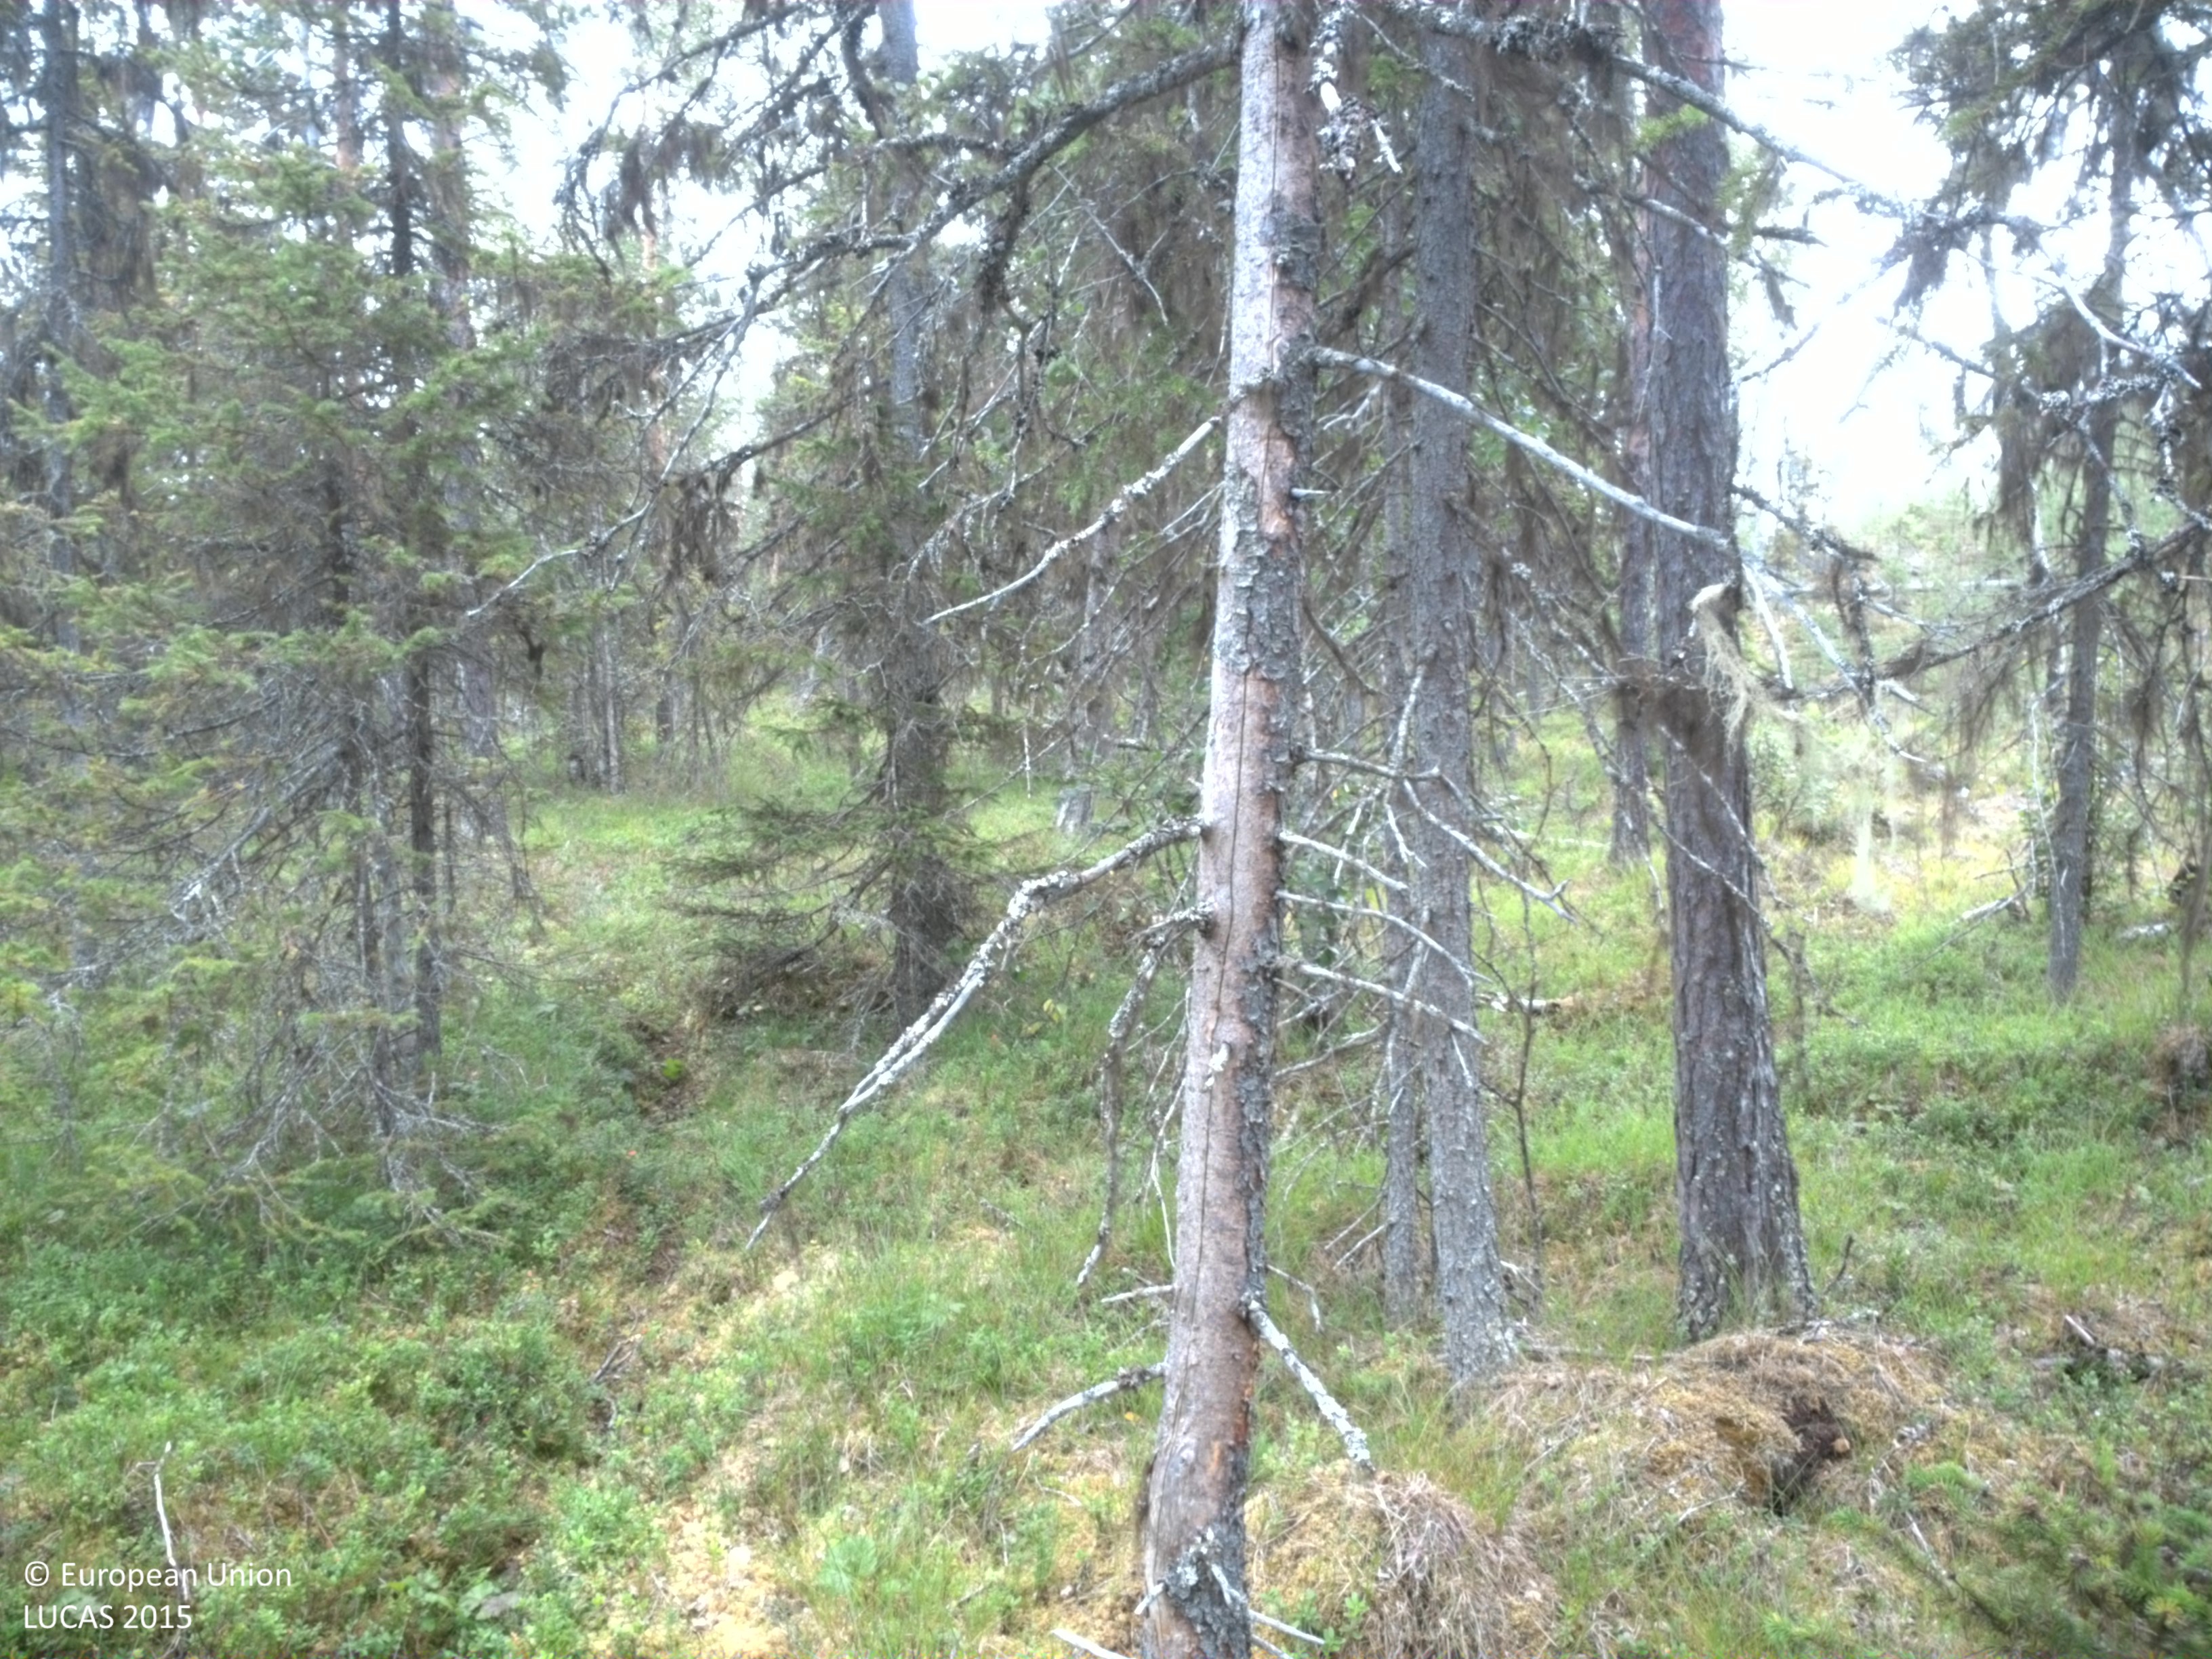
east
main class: Woodland
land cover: Spruce dominated coniferous woodland
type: boreal forest
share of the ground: 50 - 75 %
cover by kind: coniferous forest trees 50 %, shrubs 30 %, herbaceous plants 10 %, lichens and mosses 10 %
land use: Forestry
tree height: > 5 m
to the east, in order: Spruce dominated coniferous woodland; Pine dominated coniferous woodland; Broadleaved woodland; Grassland without tree/shrub cover; Inland fresh running water
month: August
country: SE
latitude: 64.5937
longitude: 19.9794
